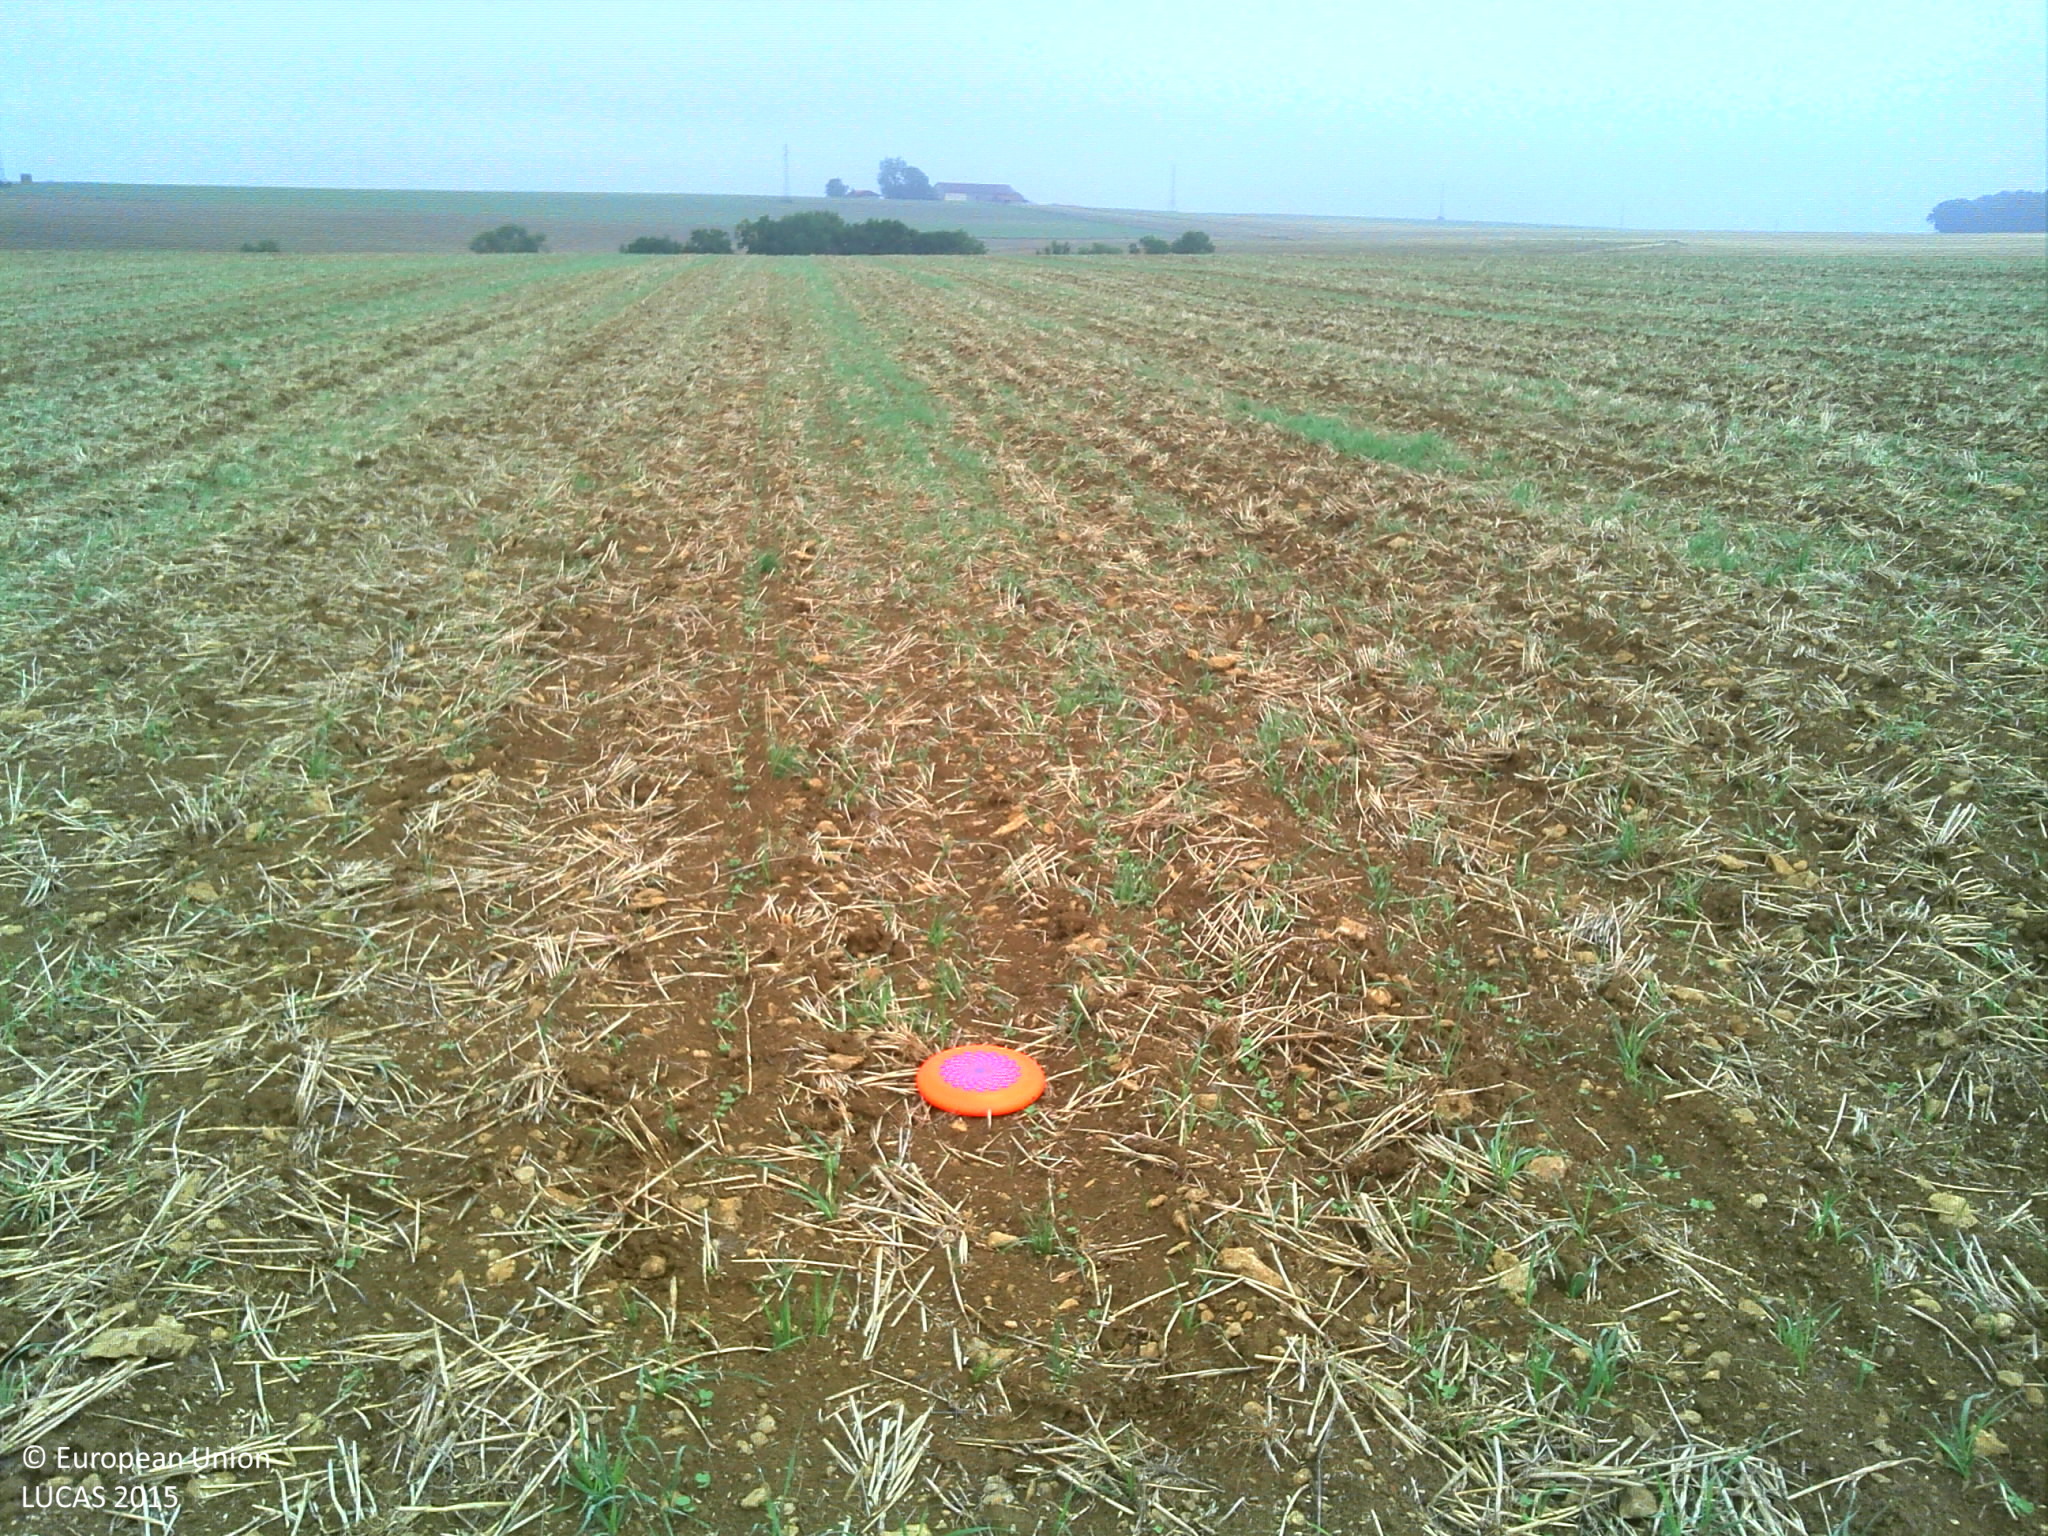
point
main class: Cropland
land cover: Other fibre and oleaginous crops
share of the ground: < 10 %
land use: Agriculture (excluding fallow land and kitchen gardens)
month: September
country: FR
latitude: 49.1751
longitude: 5.9254
